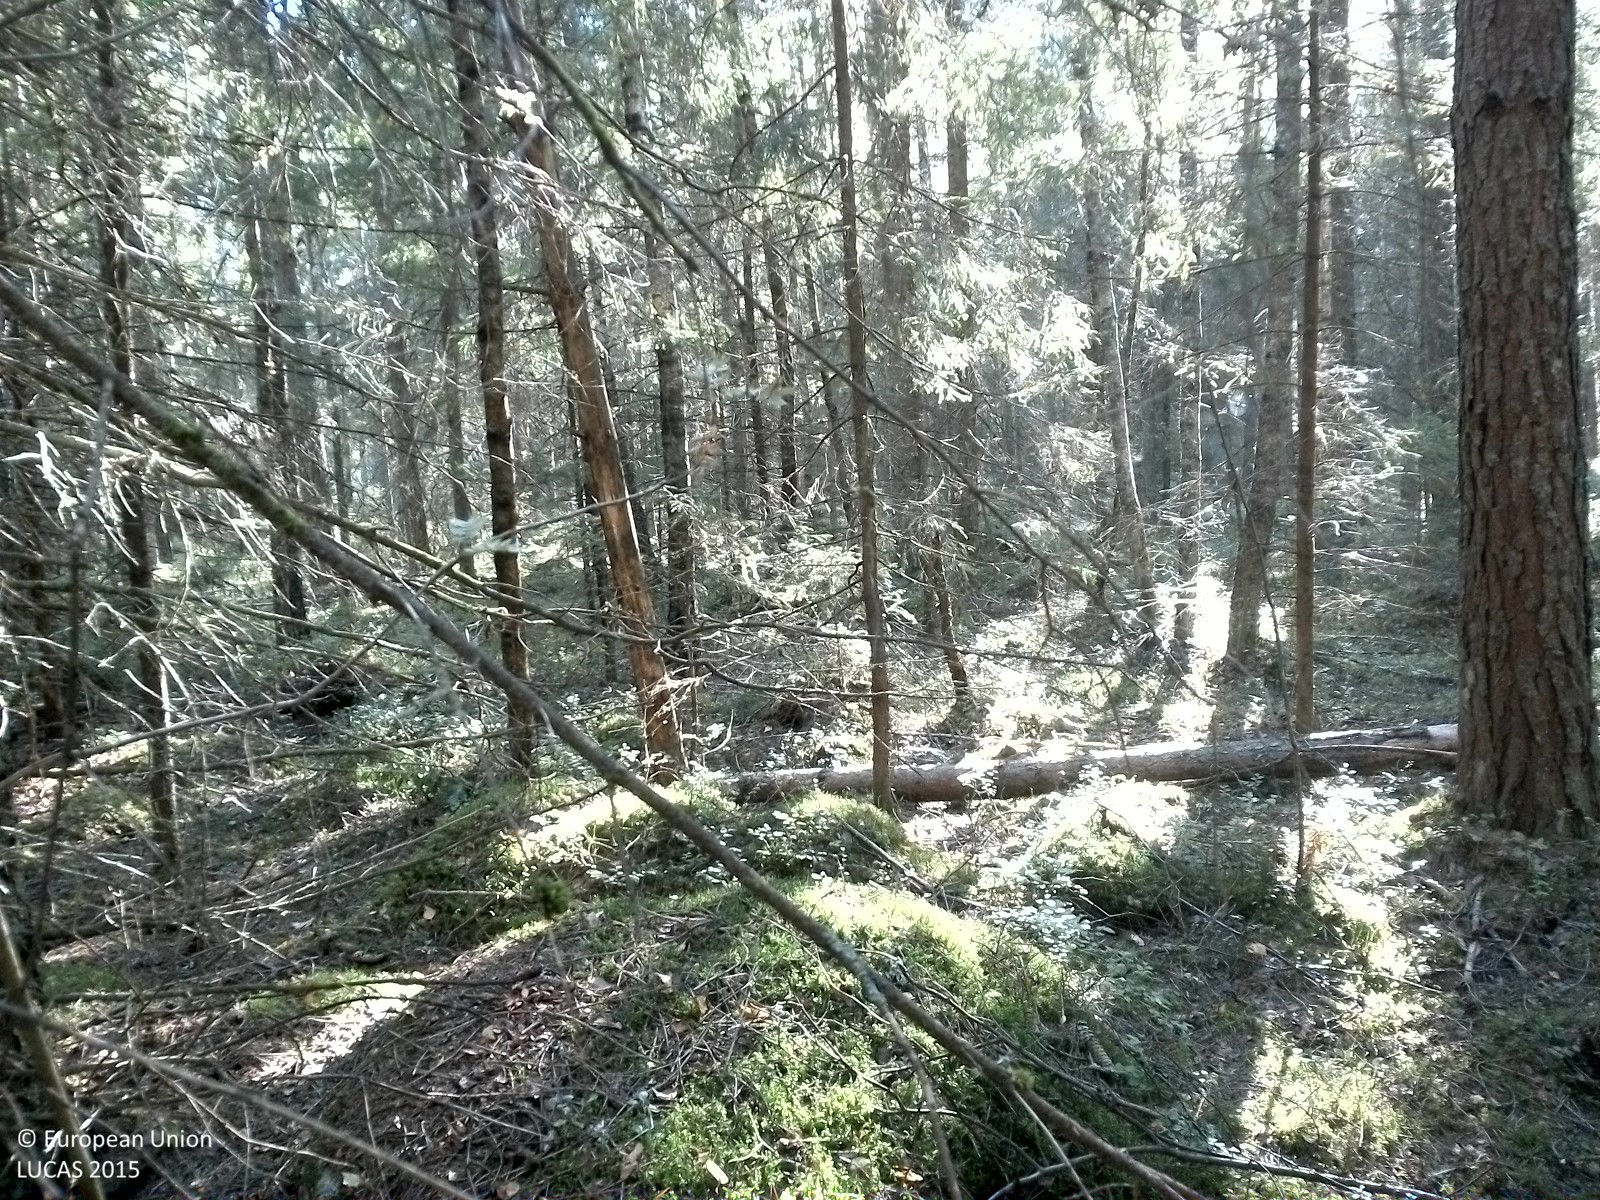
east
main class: Woodland
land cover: Other coniferous woodland
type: boreal forest
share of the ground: 50 - 75 %
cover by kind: coniferous forest trees 60 %, lichens and mosses 20 %, herbaceous plants 15 %, broadleaved forest trees 5 %
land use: Forestry
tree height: > 5 m
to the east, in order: Other coniferous woodland; Ditches and canals; Other coniferous woodland
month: August
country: SE
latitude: 59.2961
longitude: 15.0659
